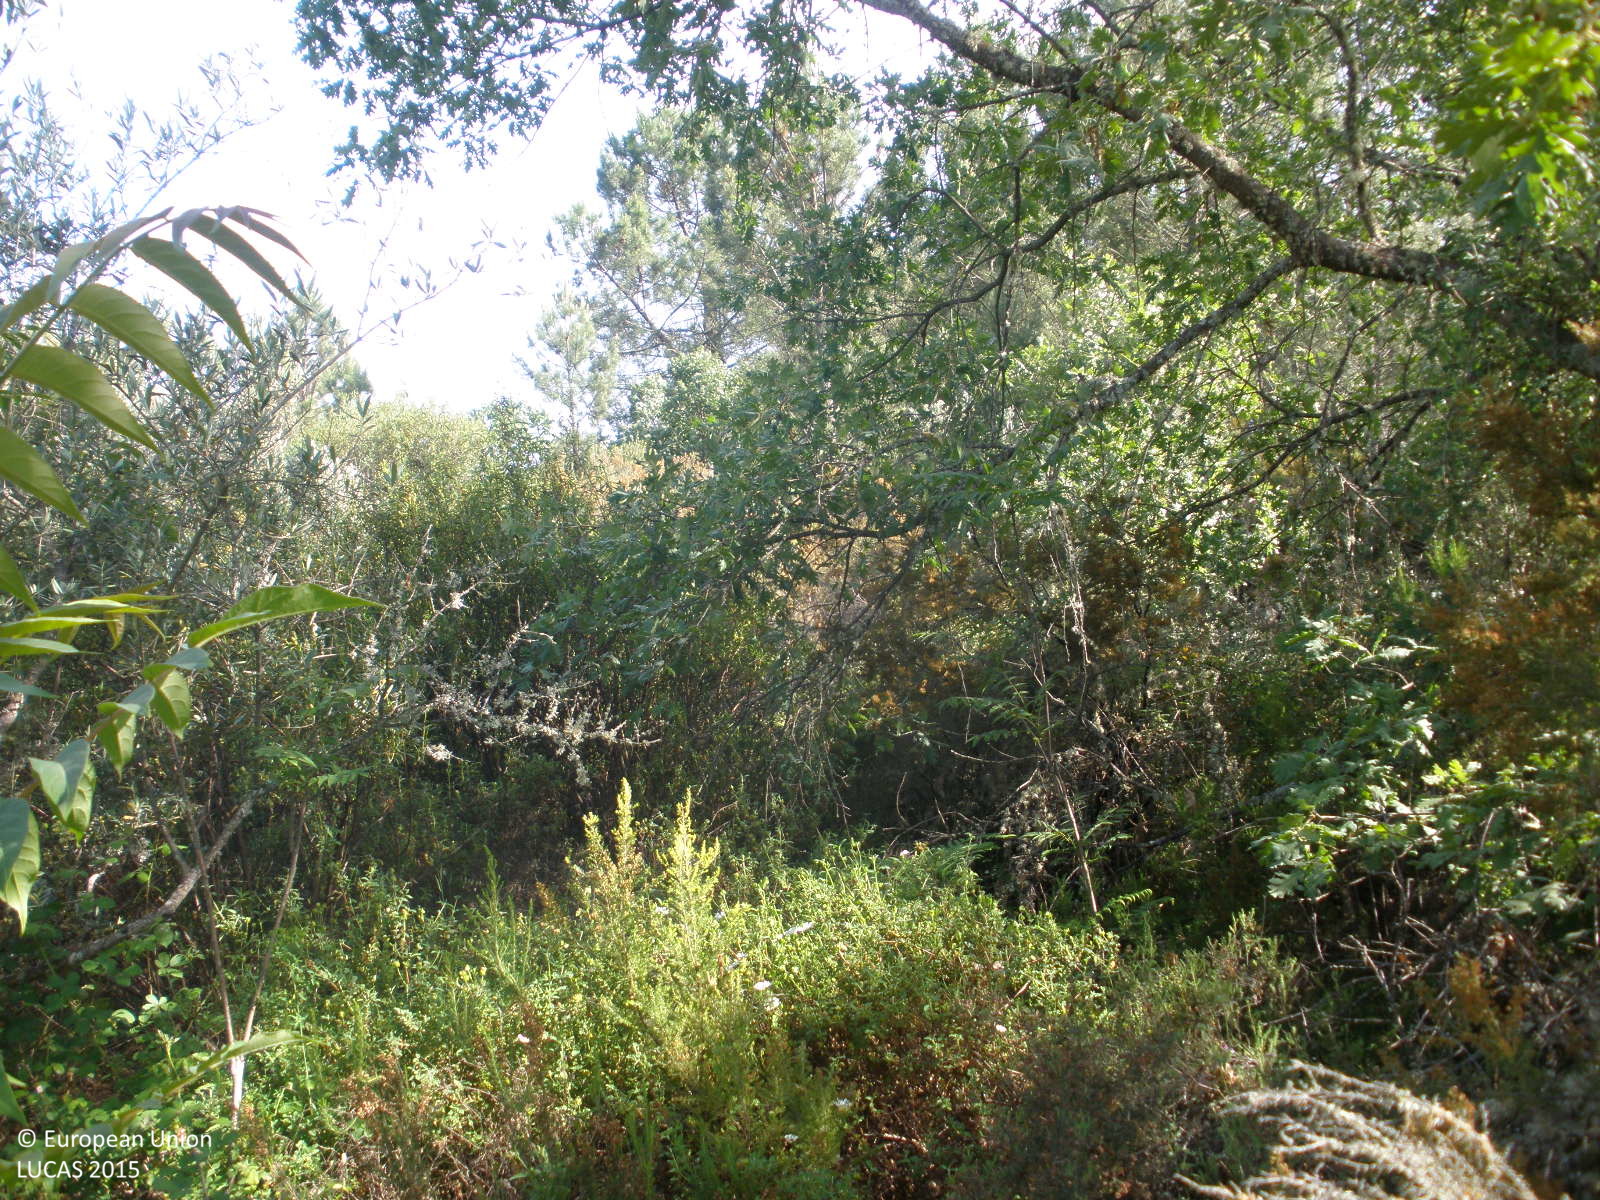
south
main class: Woodland
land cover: Broadleaved woodland
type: thermophilous deciduous forest
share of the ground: > 75 %
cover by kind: broadleaved forest trees 70 %, shrubs 30 %
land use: Semi-natural and natural areas not in use
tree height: > 5 m
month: May
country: ES
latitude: 40.1988
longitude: -6.6378
